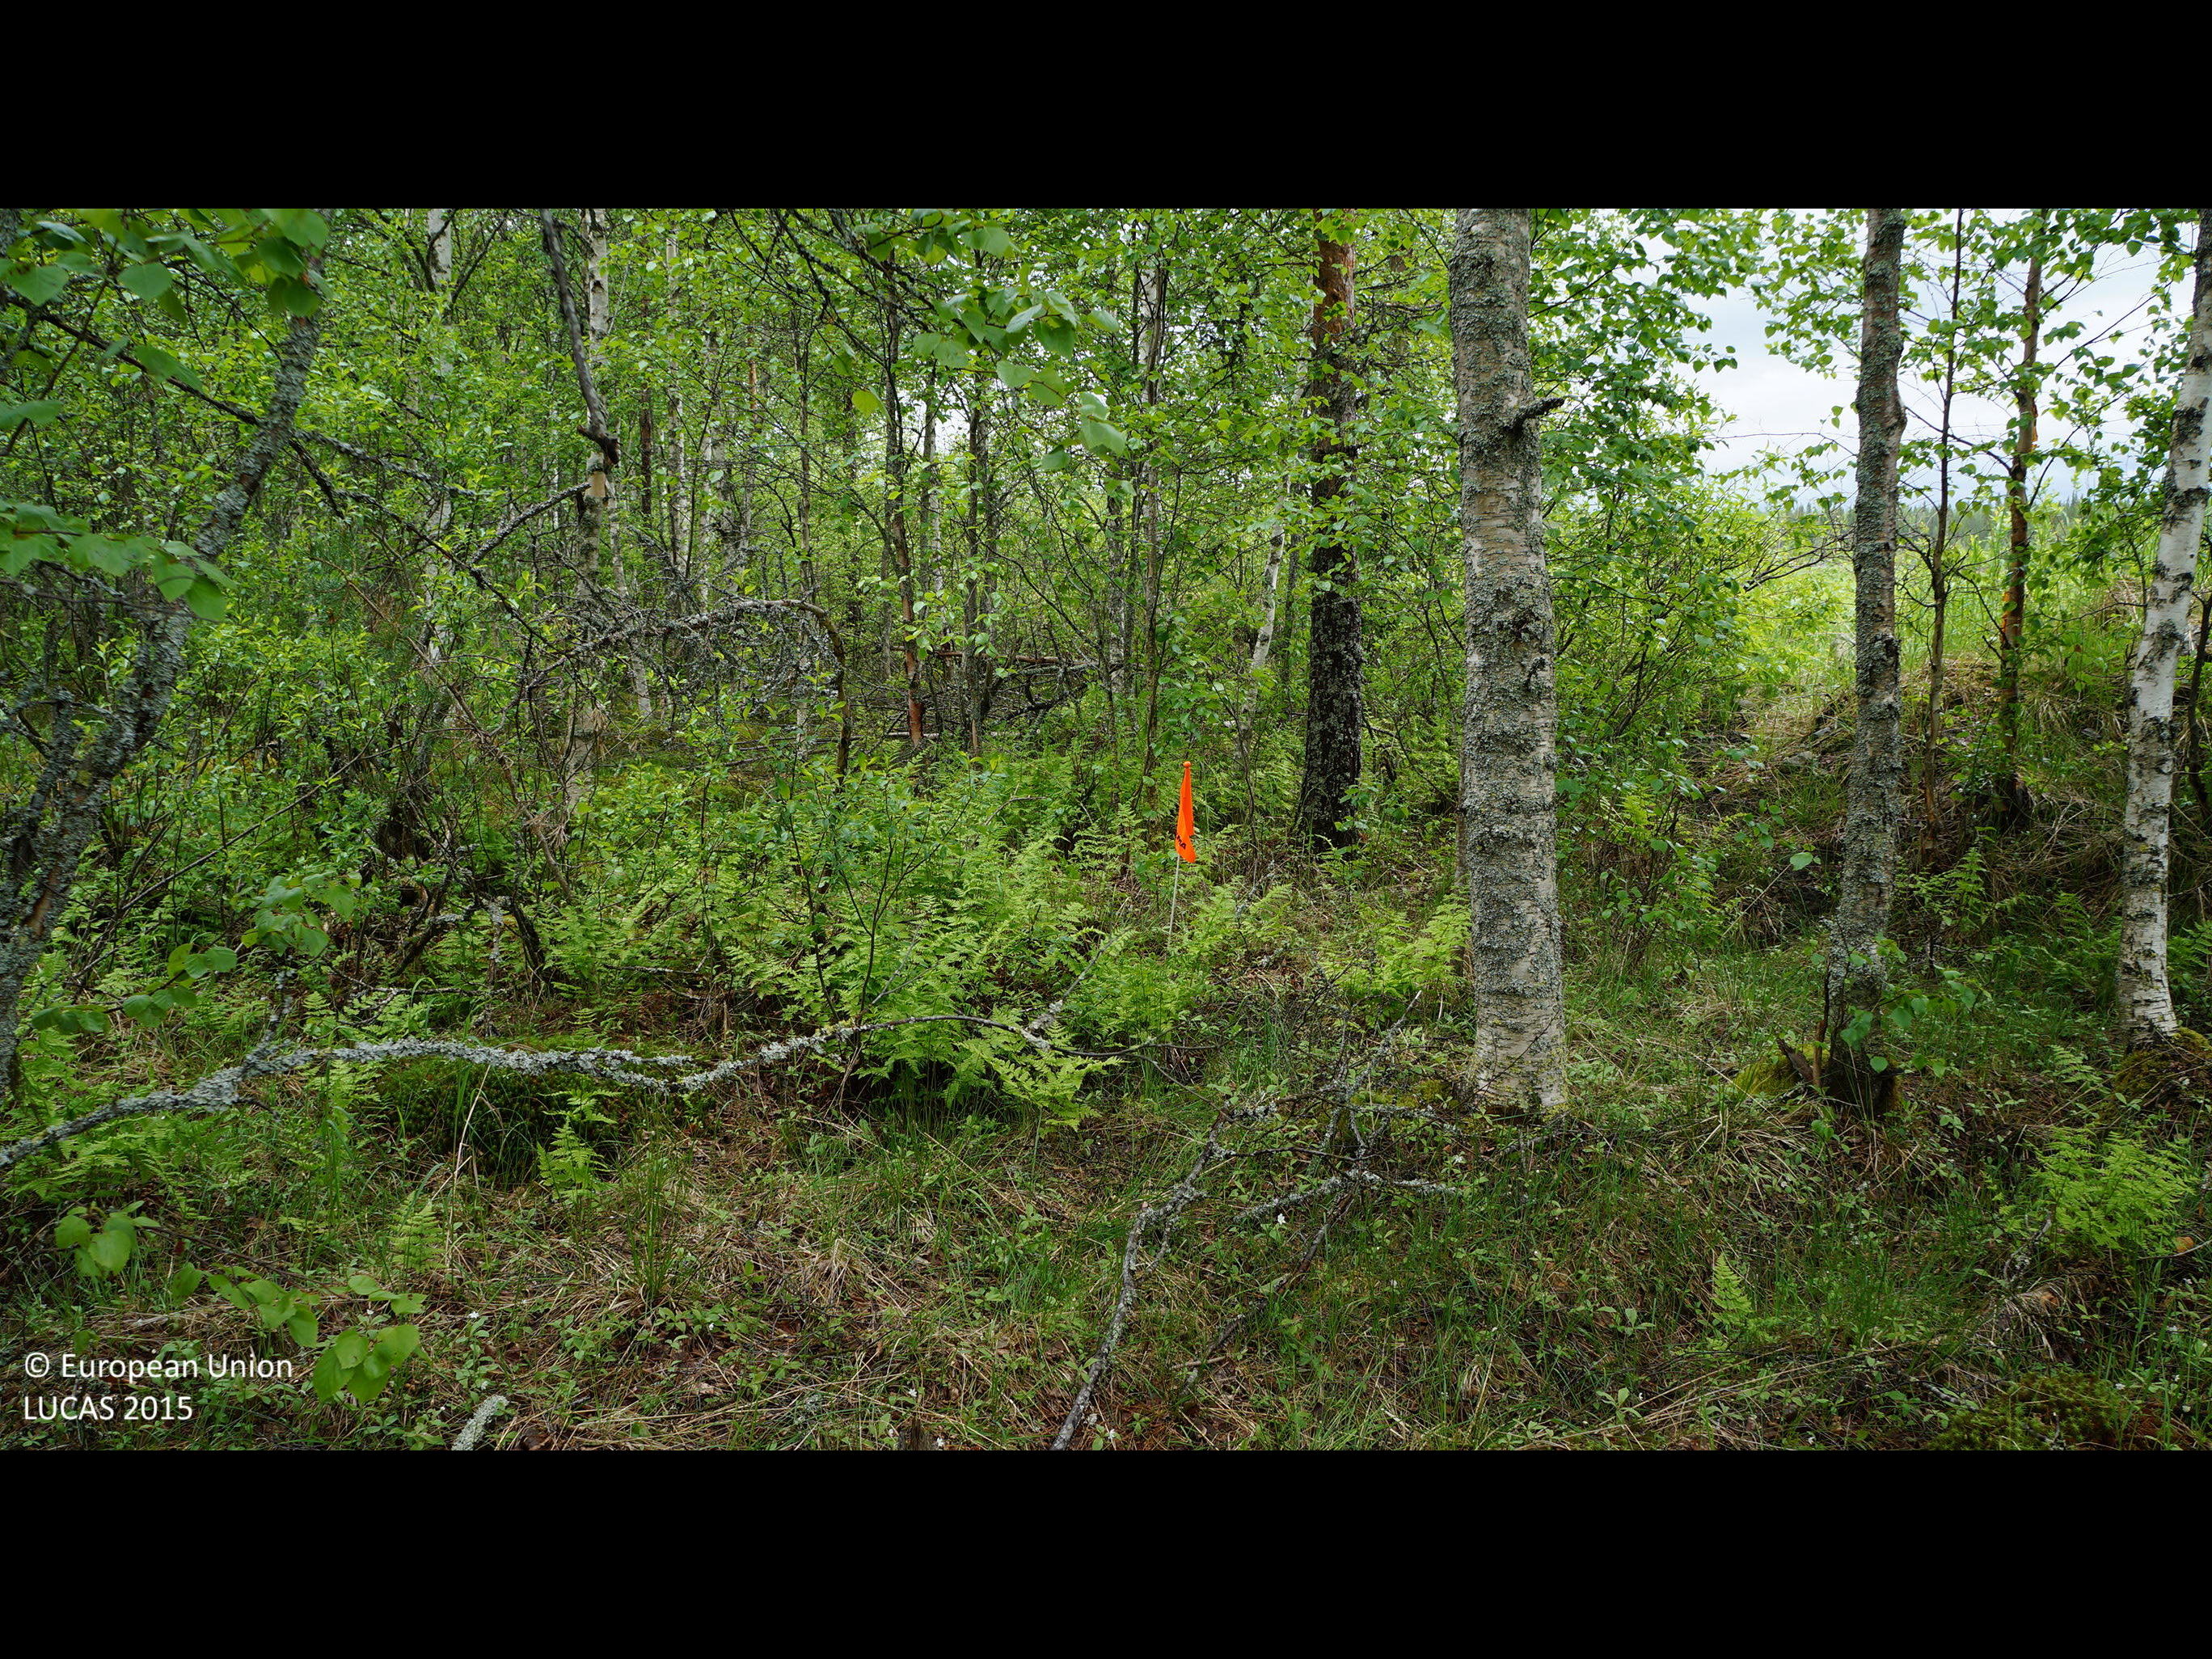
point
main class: Woodland
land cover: Broadleaved woodland
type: non-riverine alder, birch or aspen forest
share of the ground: > 75 %
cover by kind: broadleaved forest trees 90 %, shrubs 5 %, herbaceous plants 5 %
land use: Forestry
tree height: > 5 m
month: June
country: FI
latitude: 63.9888
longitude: 25.2343
